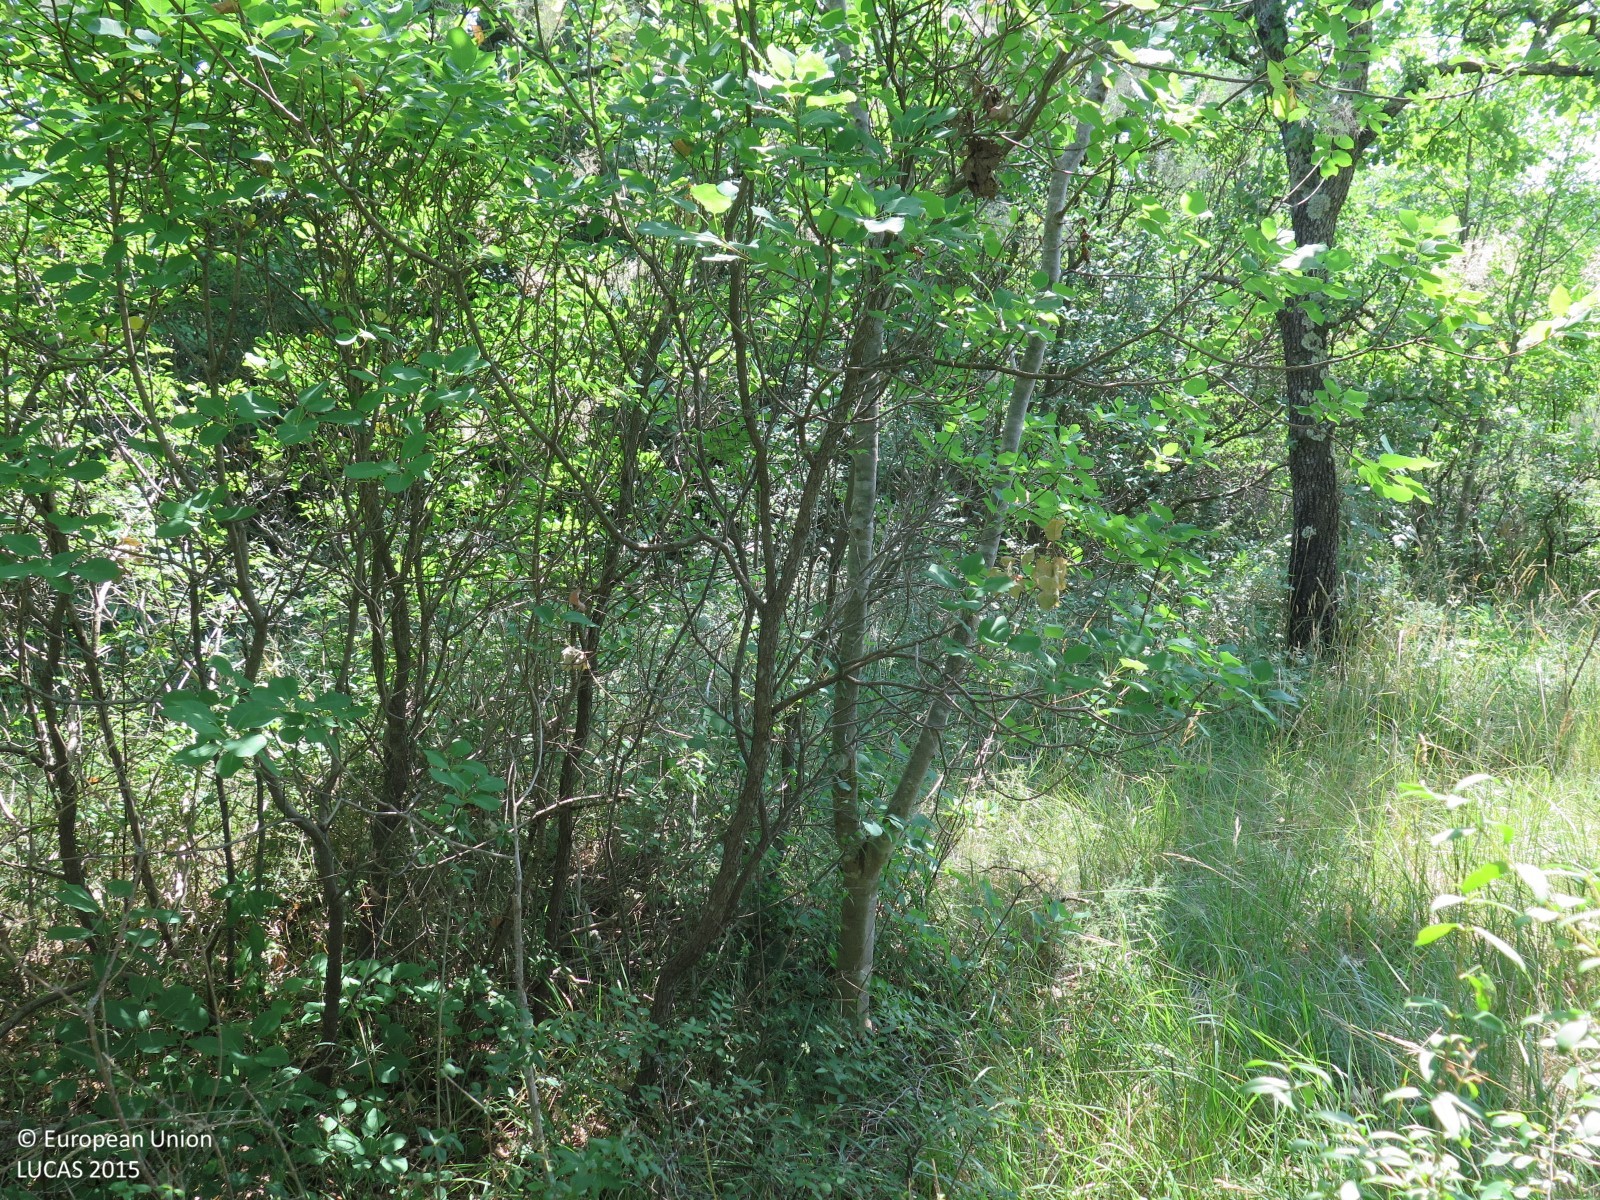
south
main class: Woodland
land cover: Broadleaved woodland
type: mesophytic deciduous forest
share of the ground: > 75 %
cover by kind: broadleaved forest trees 90 %, shrubs 5 %, herbaceous plants 5 %
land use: Semi-natural and natural areas not in use
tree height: > 5 m
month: July
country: HR
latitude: 45.4435
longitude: 13.5878
